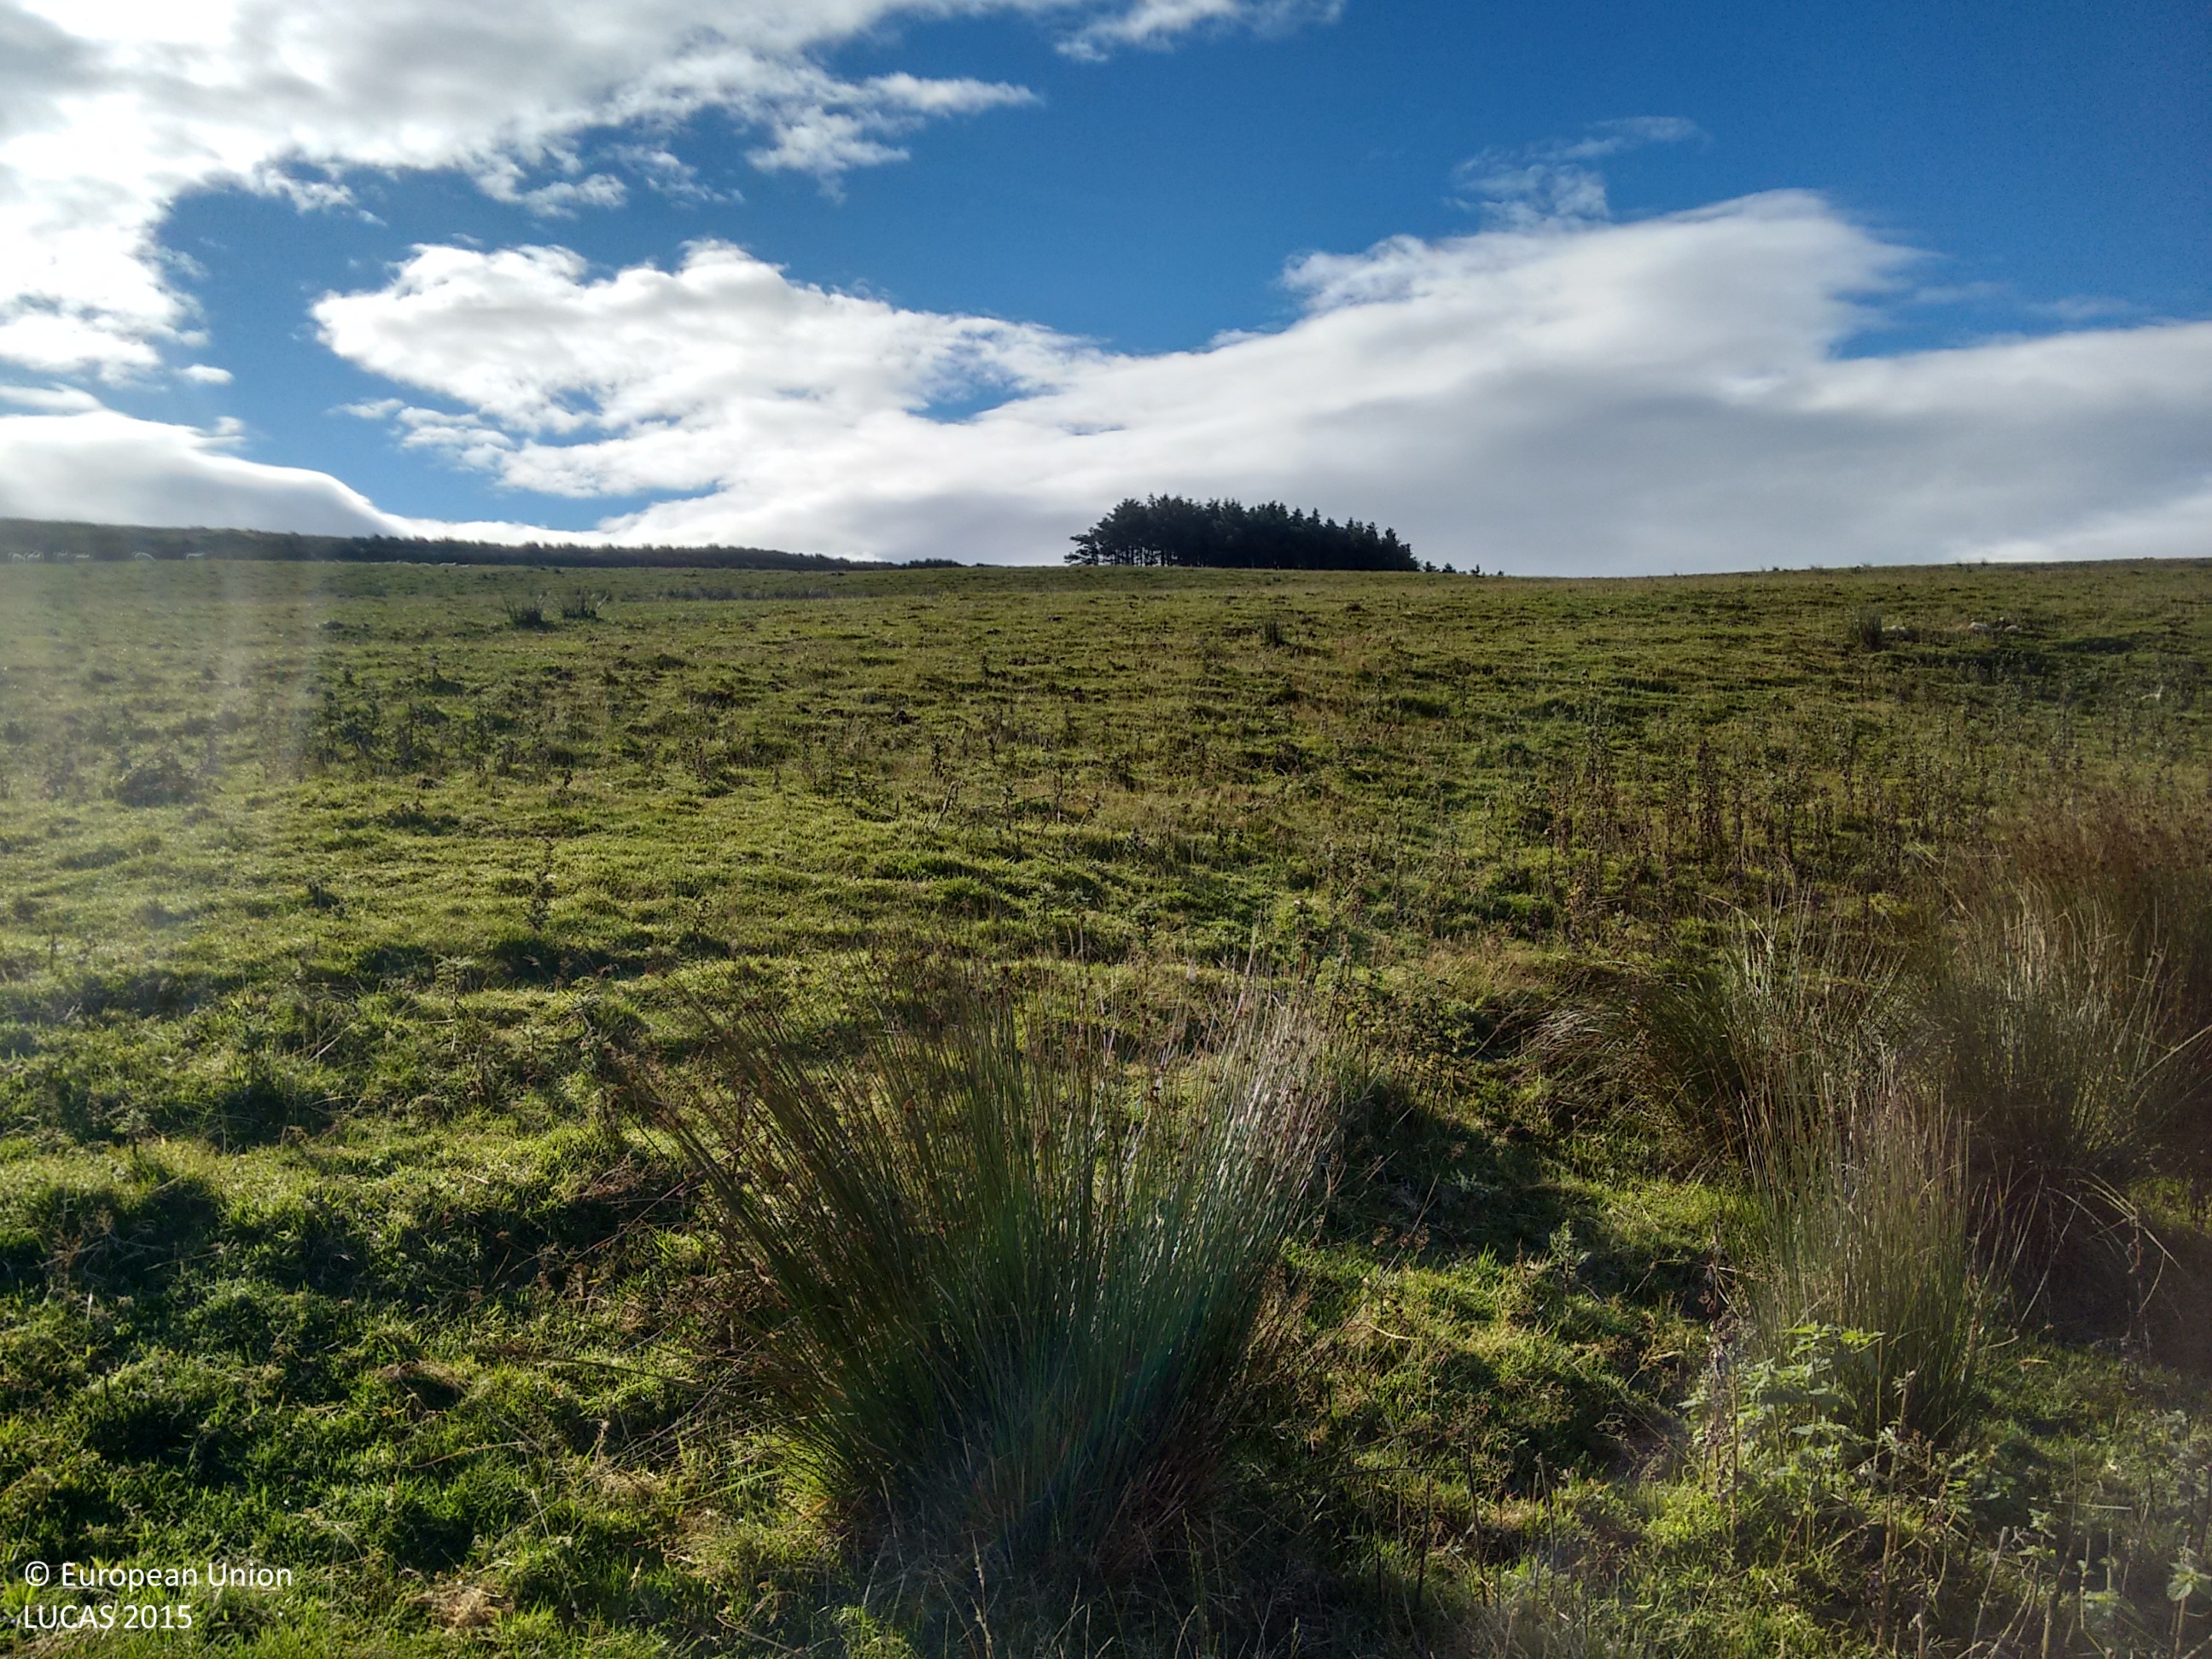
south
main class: Grassland
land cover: Grassland without tree/shrub cover
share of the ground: > 75 %
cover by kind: herbaceous plants 100 %
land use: Agriculture (excluding fallow land and kitchen gardens)
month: September
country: GB
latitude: 55.3281
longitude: -5.6547
